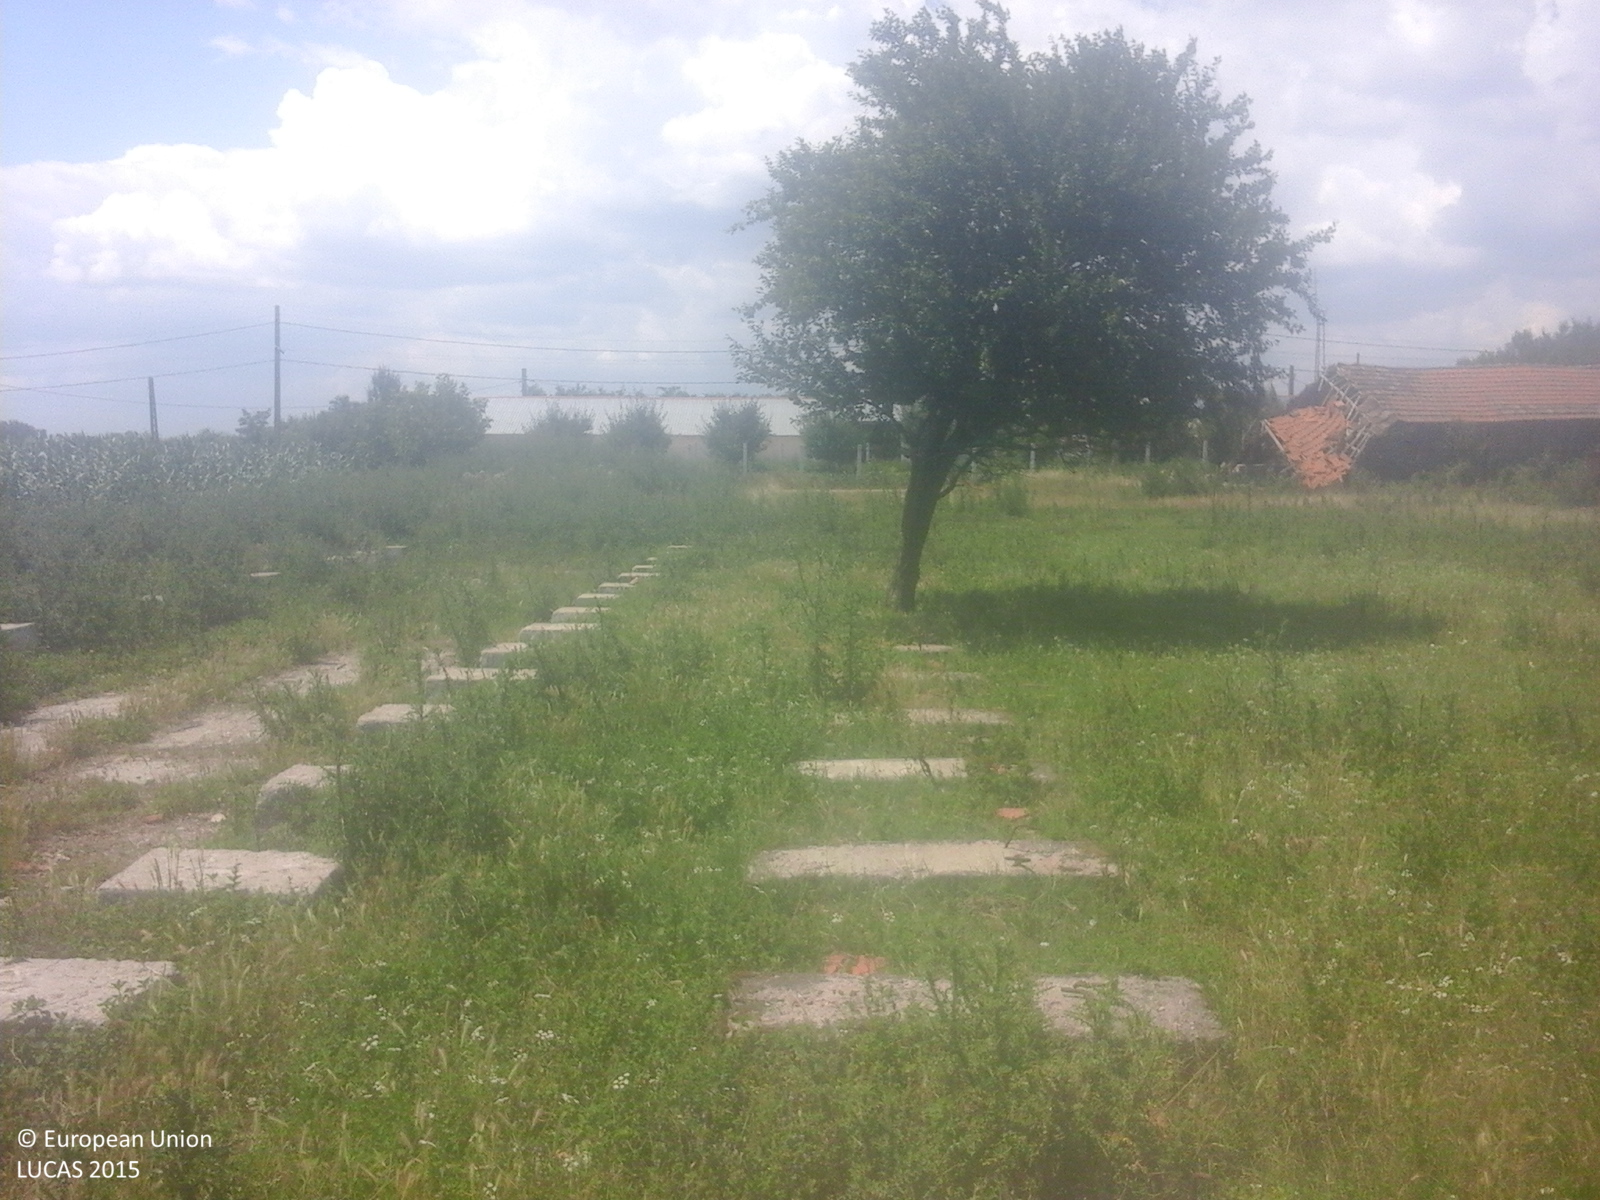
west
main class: Grassland
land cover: Spontaneously vegetated surfaces
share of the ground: > 75 %
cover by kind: herbaceous plants 90 %, consolidated bare surface 10 %
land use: Abandoned areas
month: July
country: RO
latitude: 44.1590
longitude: 25.5575
